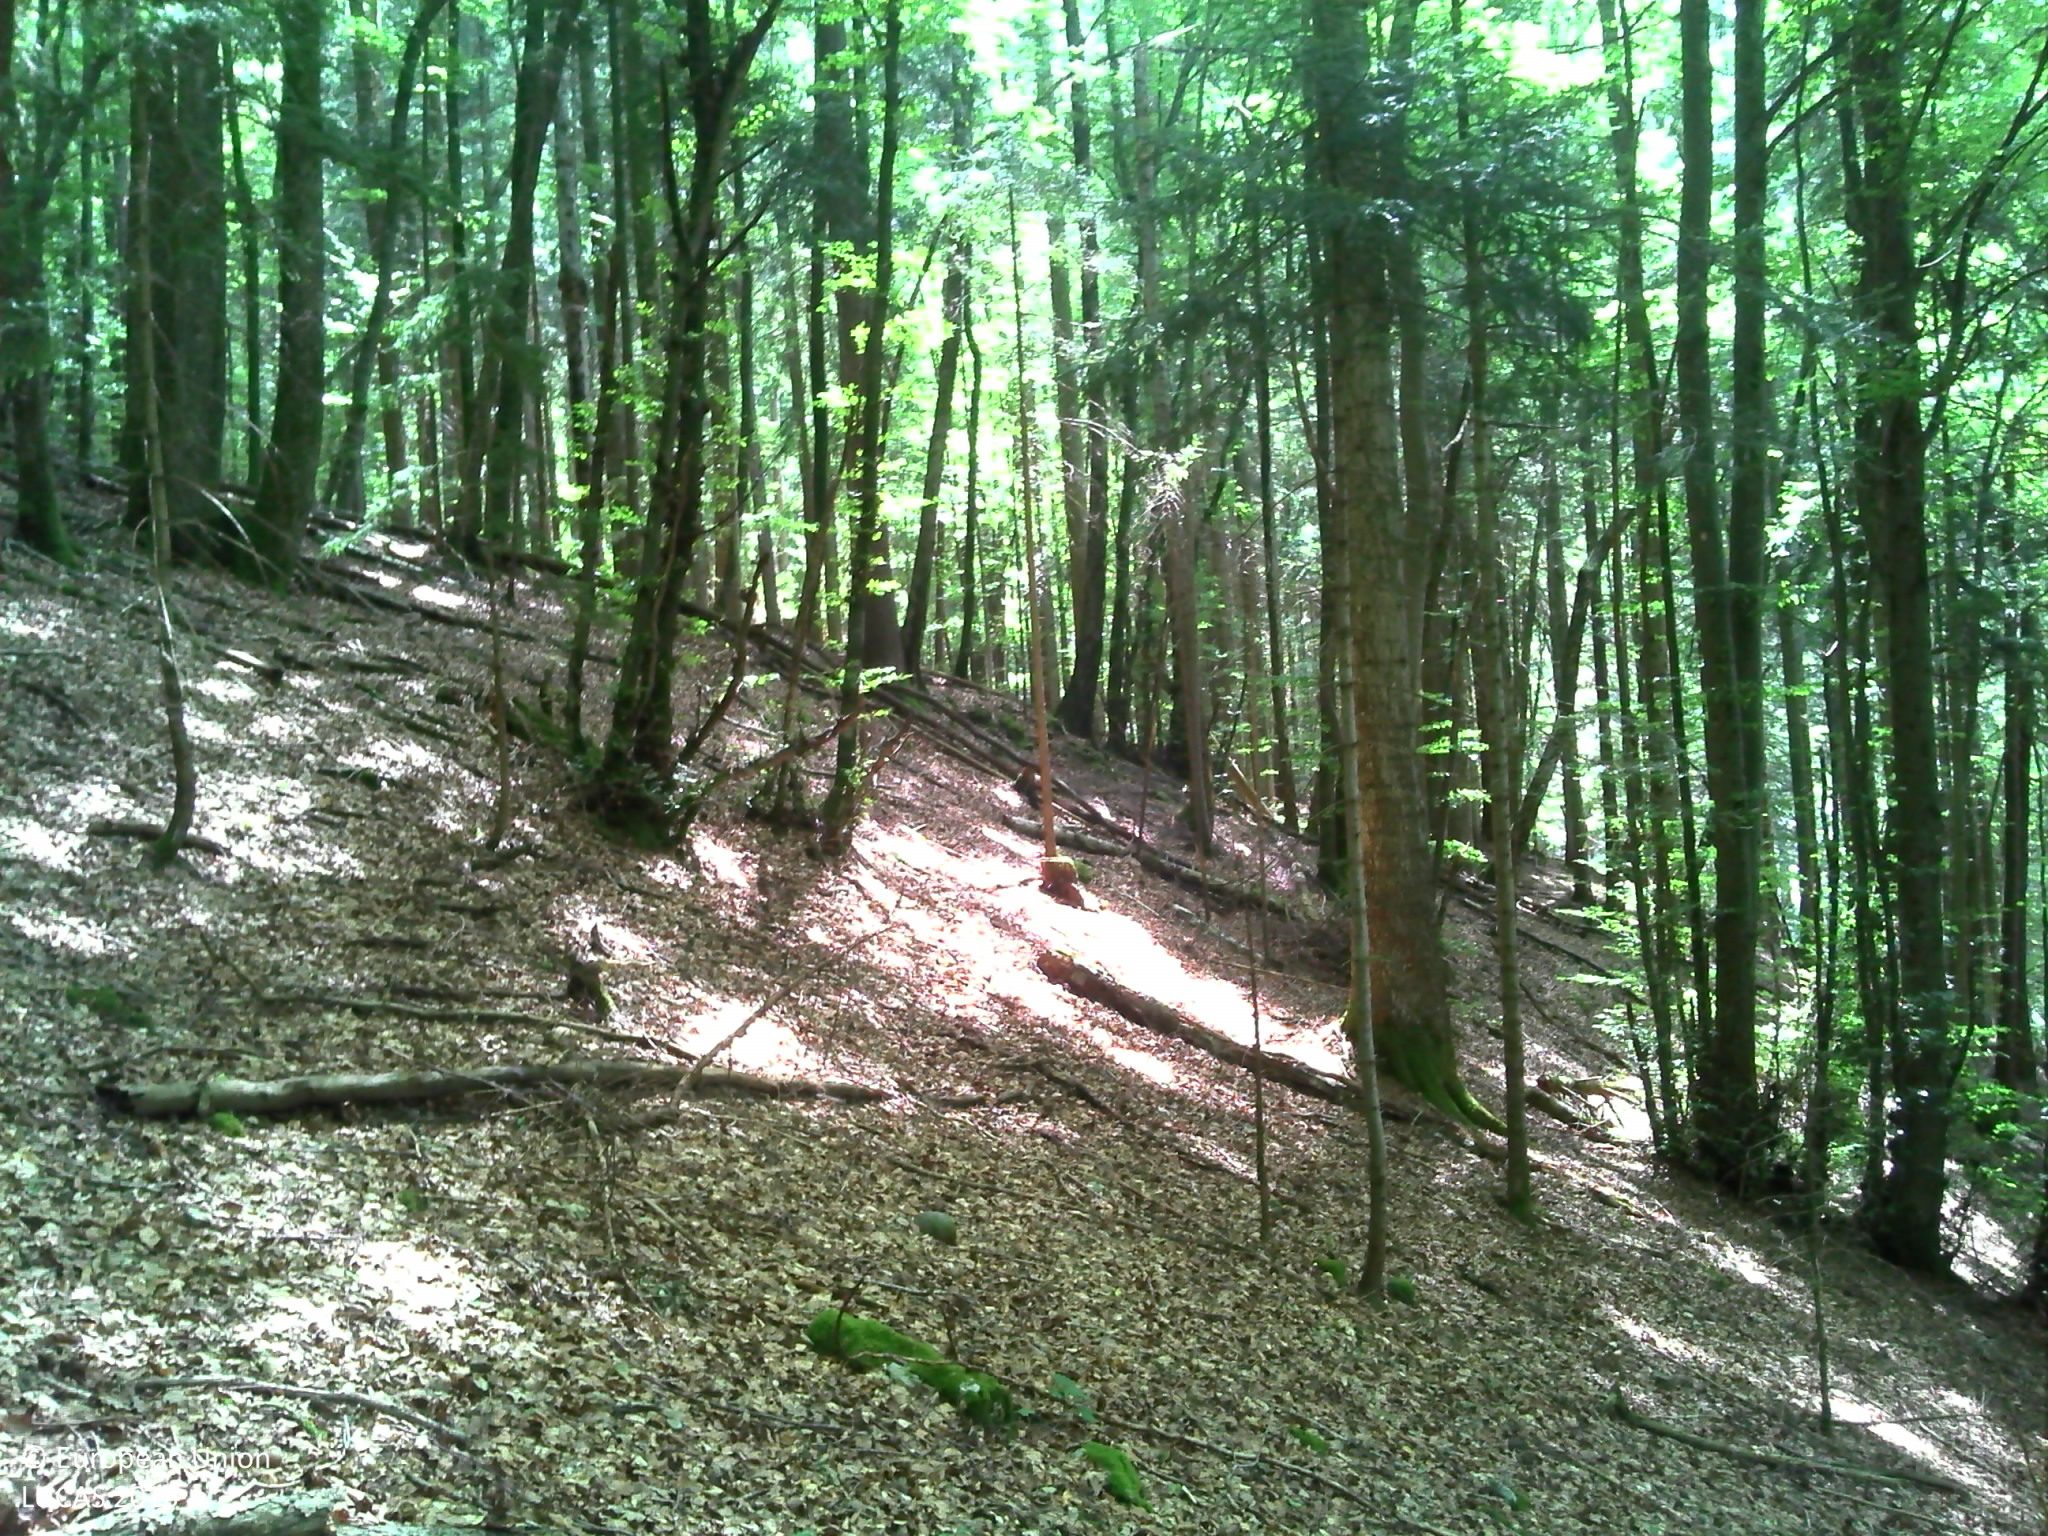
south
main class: Woodland
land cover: Broadleaved woodland
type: beech forest
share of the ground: > 75 %
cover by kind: broadleaved forest trees 75 %, coniferous forest trees 15 %, herbaceous plants 5 %, lichens and mosses 5 %
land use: Forestry
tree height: > 5 m
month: July
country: FR
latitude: 46.1307
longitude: 6.4701
